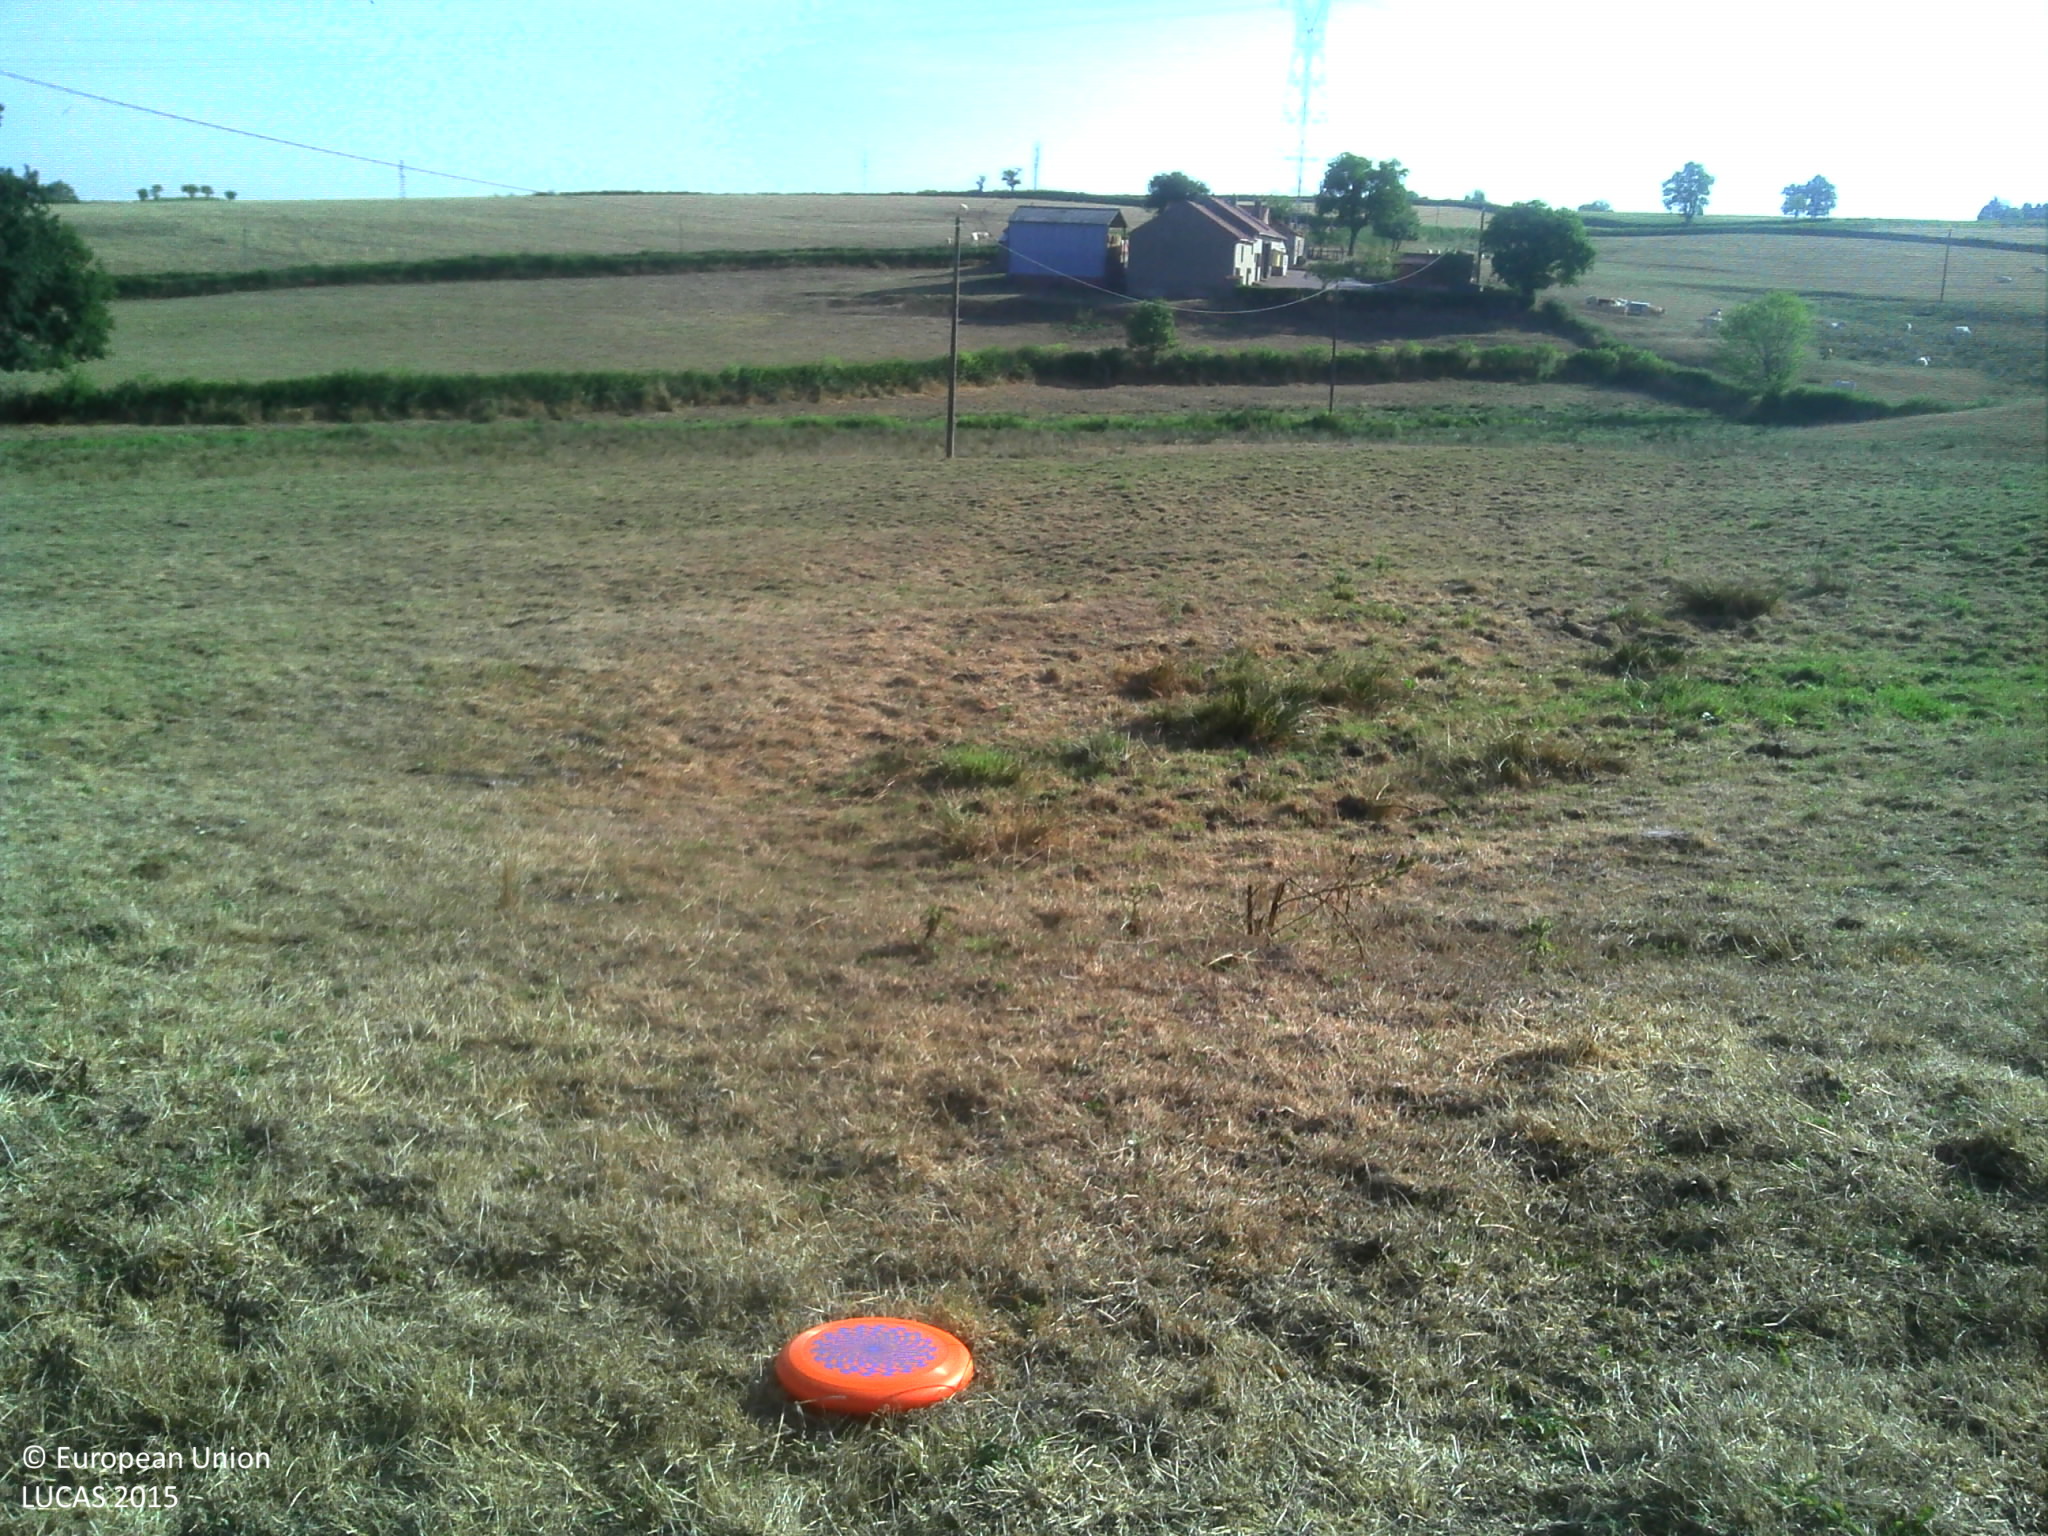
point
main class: Grassland
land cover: Grassland without tree/shrub cover
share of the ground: > 75 %
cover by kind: herbaceous plants 100 %
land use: Agriculture (excluding fallow land and kitchen gardens)
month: August
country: FR
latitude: 46.7121
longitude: 4.4412
